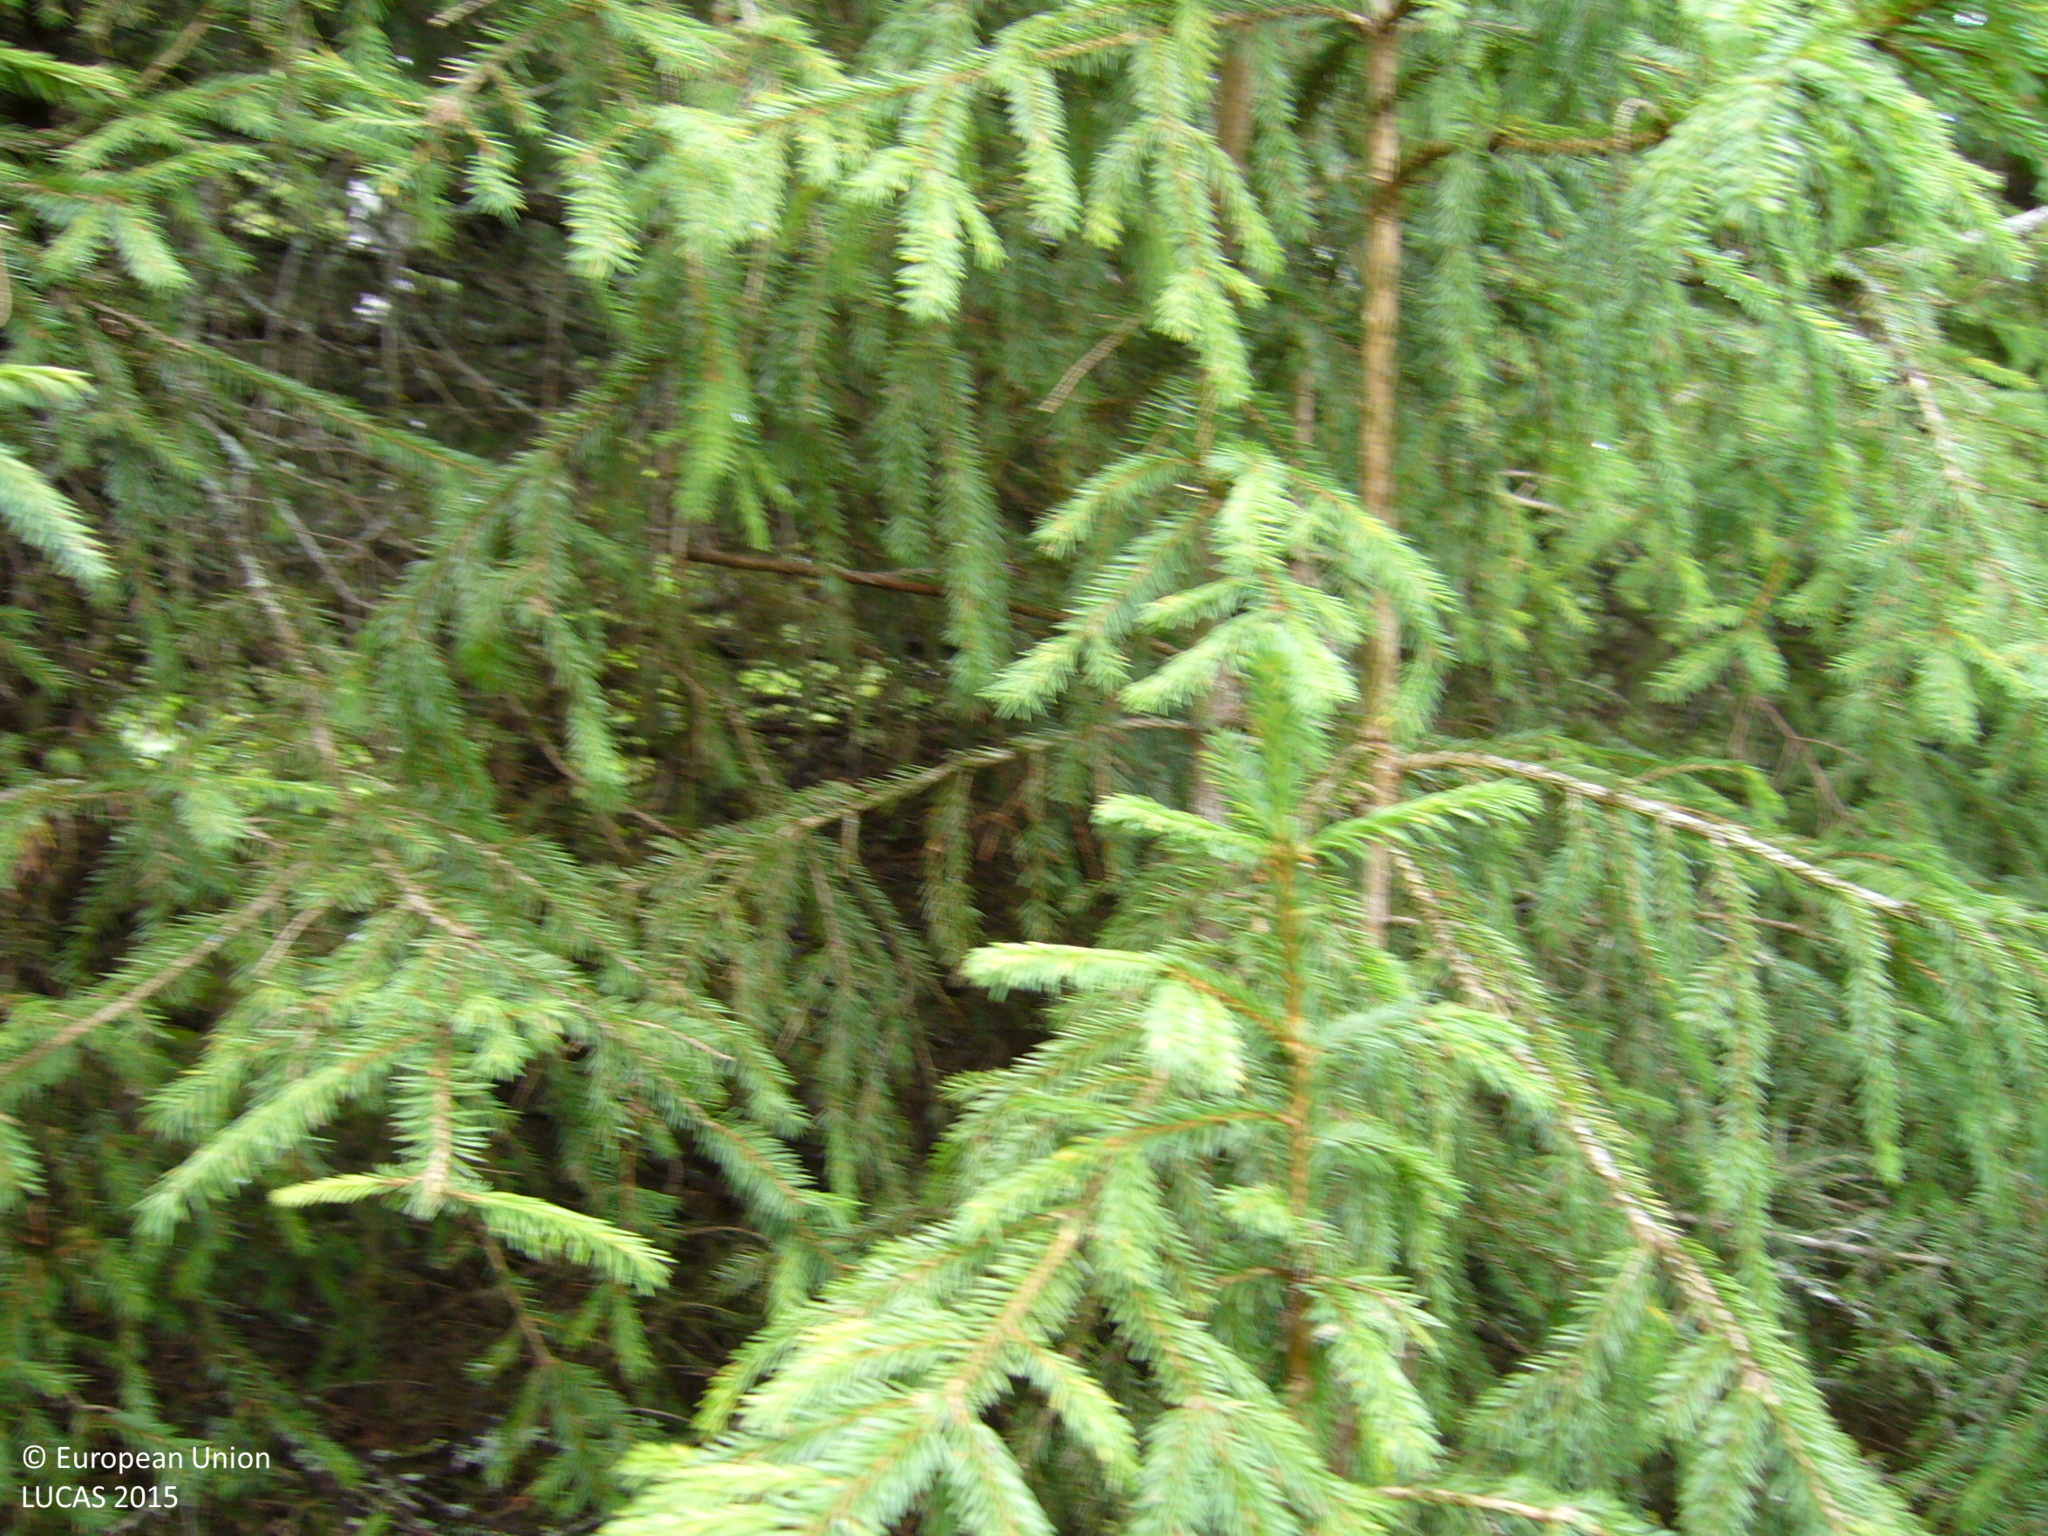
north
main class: Woodland
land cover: Spruce dominated mixed woodland
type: boreal forest
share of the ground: > 75 %
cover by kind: coniferous forest trees 70 %, broadleaved forest trees 25 %, shrubs 5 %
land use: Forestry
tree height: > 5 m
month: July
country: FI
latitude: 64.0096
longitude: 26.1254
